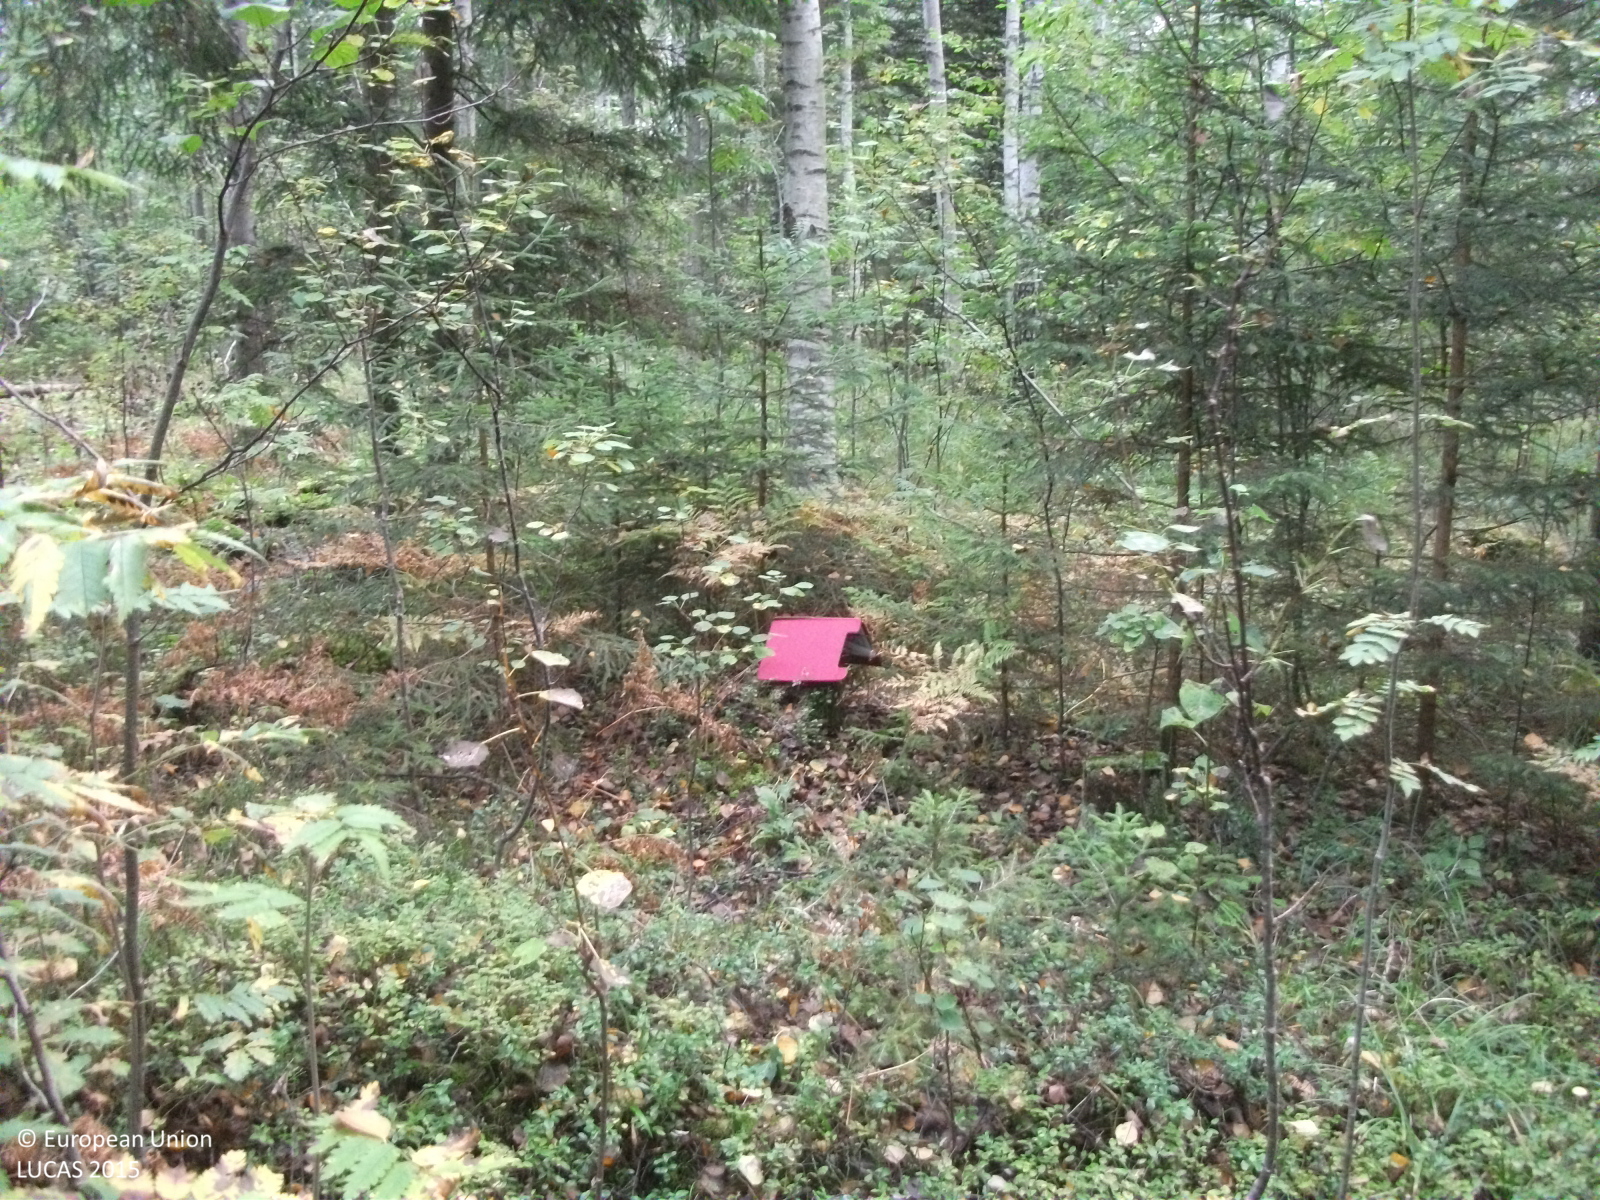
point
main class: Woodland
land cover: Spruce dominated mixed woodland
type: hemiboreal forest and nemoral coniferous forest and mixed broadleaved-coniferous forest
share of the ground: > 75 %
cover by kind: broadleaved forest trees 50 %, coniferous forest trees 35 %, herbaceous plants 10 %, shrubs 5 %
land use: Forestry
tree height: > 5 m
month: September
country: LV
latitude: 57.6948
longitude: 24.3982
